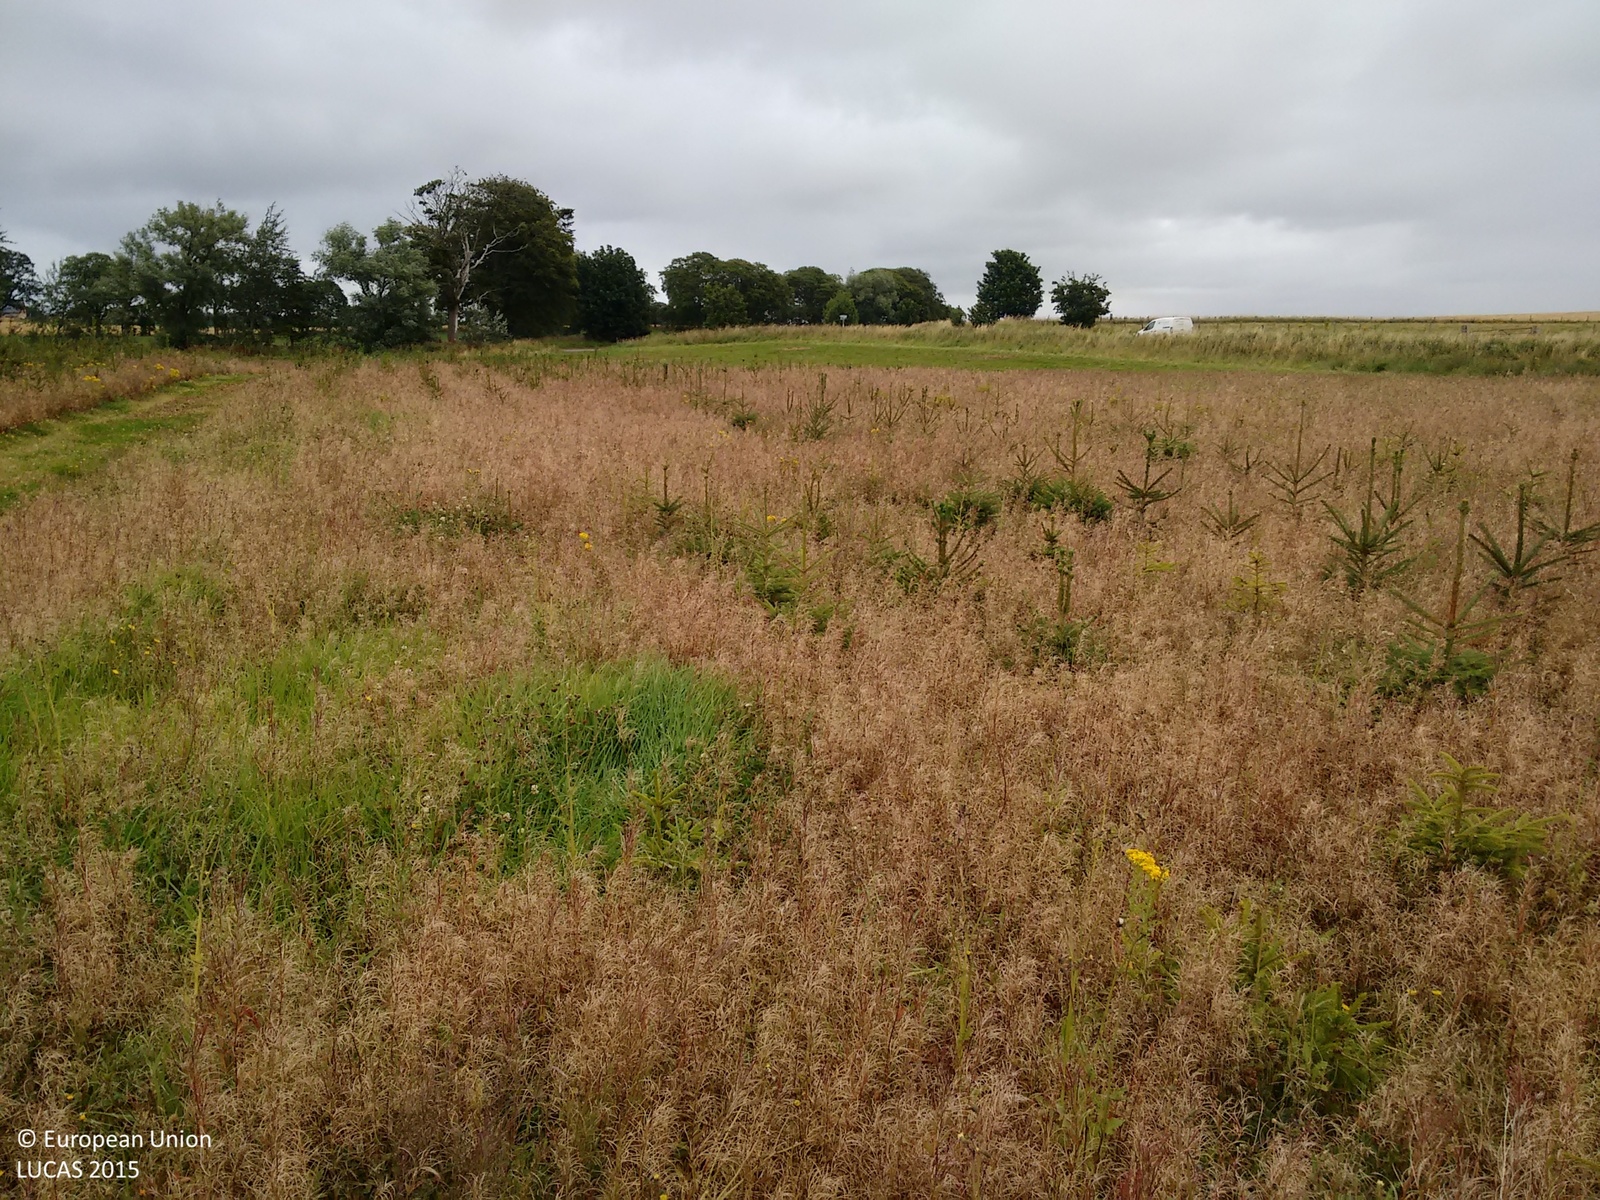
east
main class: Woodland
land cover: Spruce dominated coniferous woodland
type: exotic forest
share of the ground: < 10 %
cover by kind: herbaceous plants 90 %, coniferous forest trees 10 %
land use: Forestry
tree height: < 5 m
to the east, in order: Spruce dominated coniferous woodland; Grassland without tree/shrub cover; Fences; Grassland without tree/shrub cover; Paved roads, cycling and walking lanes; Grassland without tree/shrub cover; Single bushes/trees; Fences; Barley
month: September
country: GB
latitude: 57.6902
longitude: -3.4033
